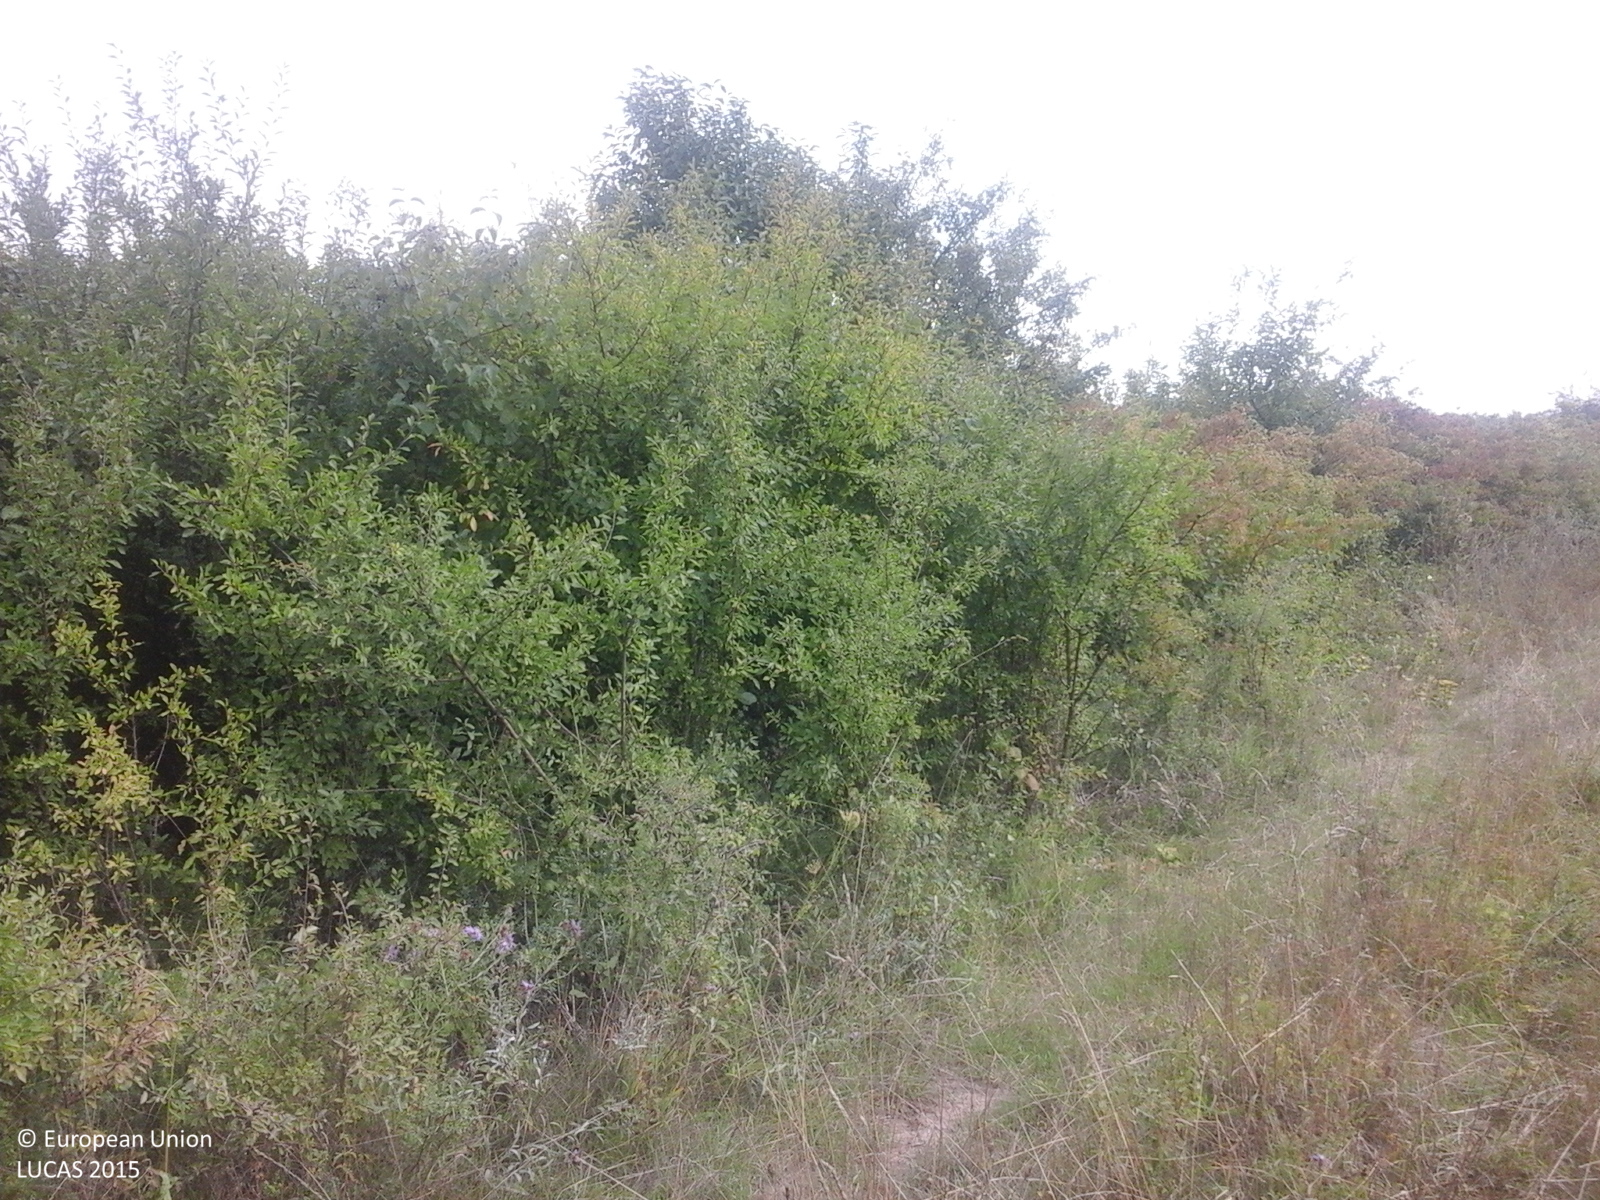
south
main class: Cropland
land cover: Maize
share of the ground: > 75 %
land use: Agriculture (excluding fallow land and kitchen gardens)
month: August
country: RO
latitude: 46.3775
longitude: 21.3857
